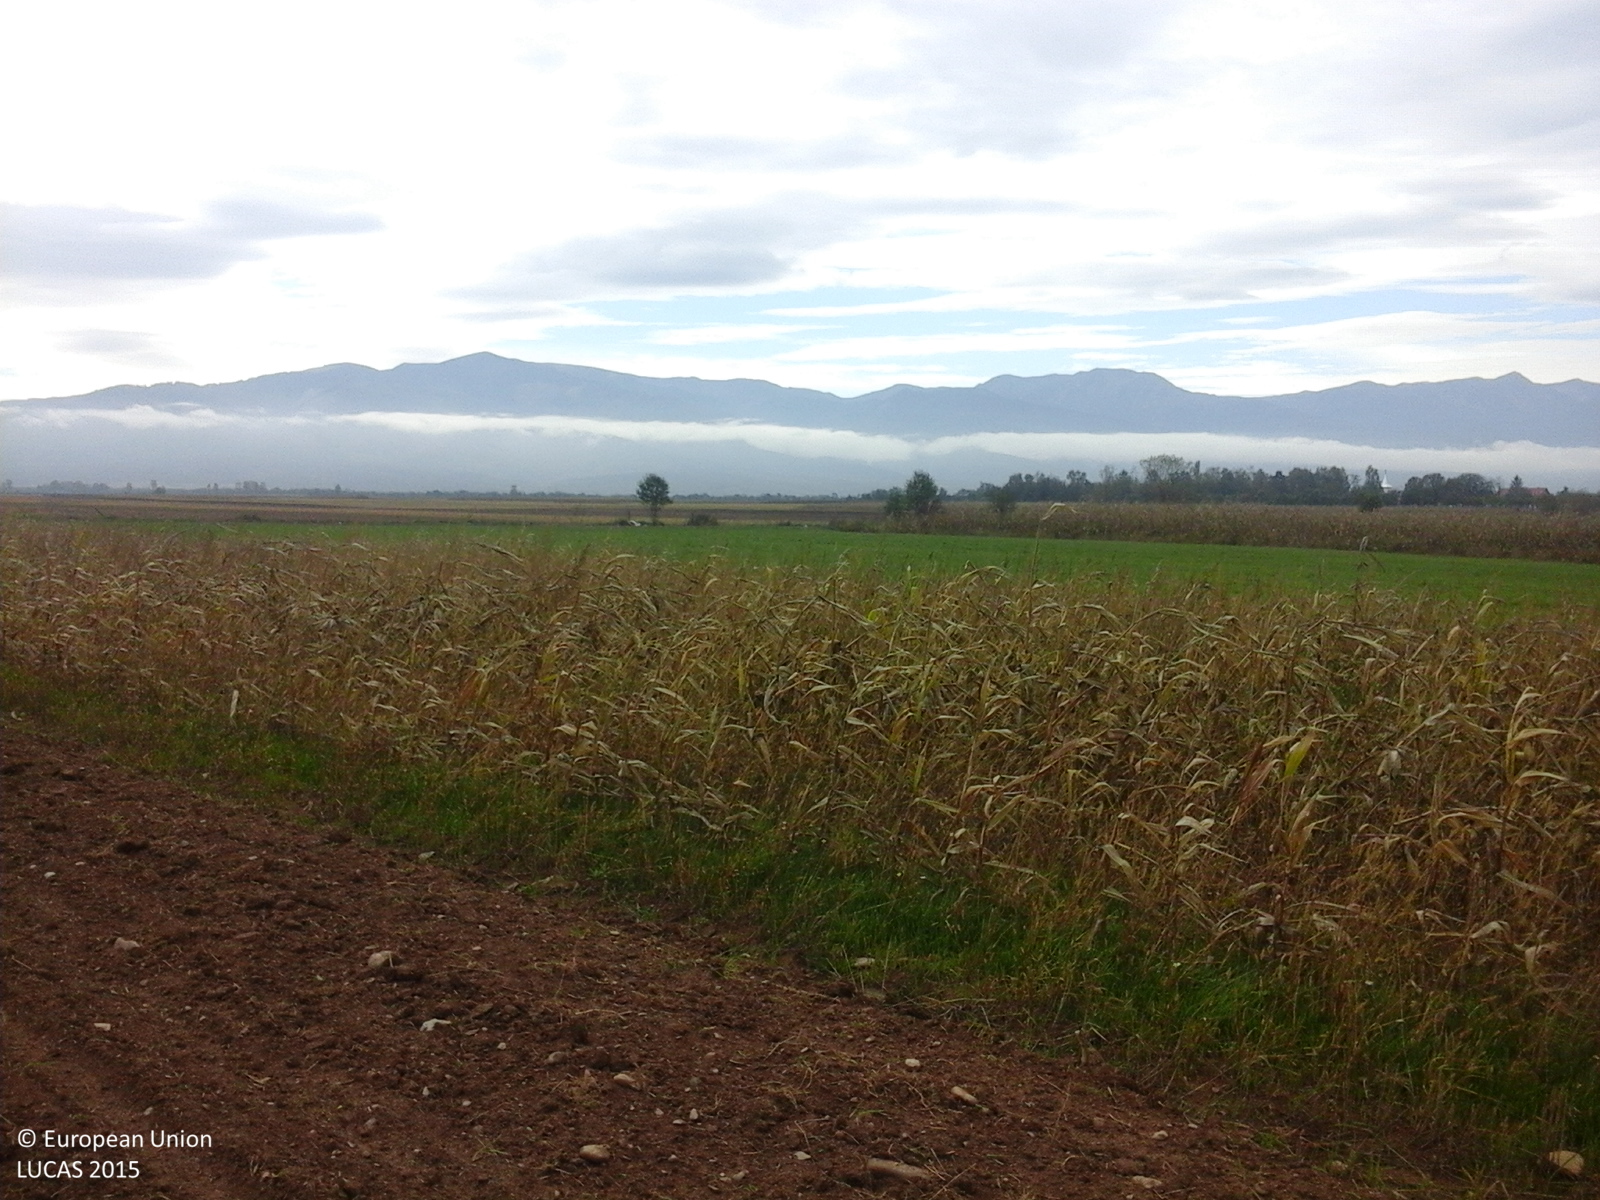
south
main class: Cropland
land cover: Common wheat
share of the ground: < 10 %
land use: Agriculture (excluding fallow land and kitchen gardens)
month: October
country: RO
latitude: 45.7593
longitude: 25.0190
